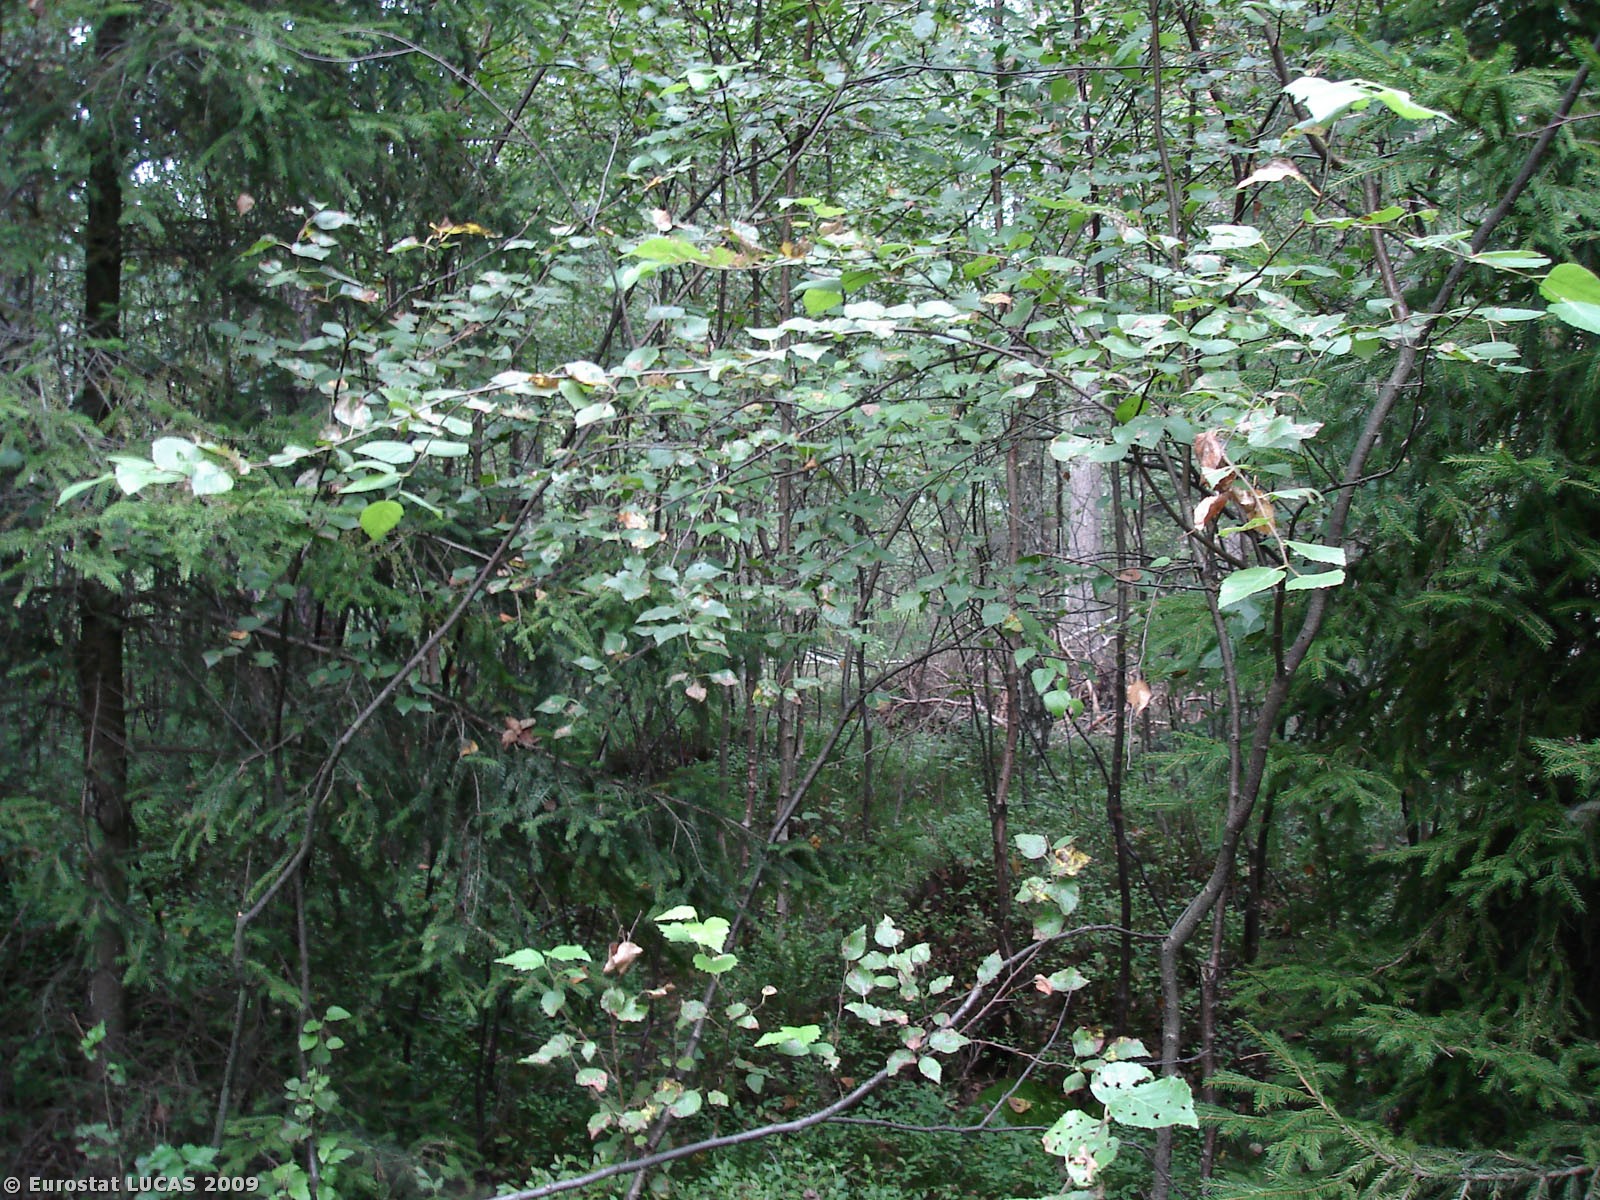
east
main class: Woodland
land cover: Mixed woodland
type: hemiboreal forest and nemoral coniferous forest and mixed broadleaved-coniferous forest
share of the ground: > 75 %
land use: Forestry
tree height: > 5 m
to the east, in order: Mixed woodland; Coniferous woodland; Tracks; Coniferous woodland
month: August
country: PL
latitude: 50.7640
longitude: 18.8262
